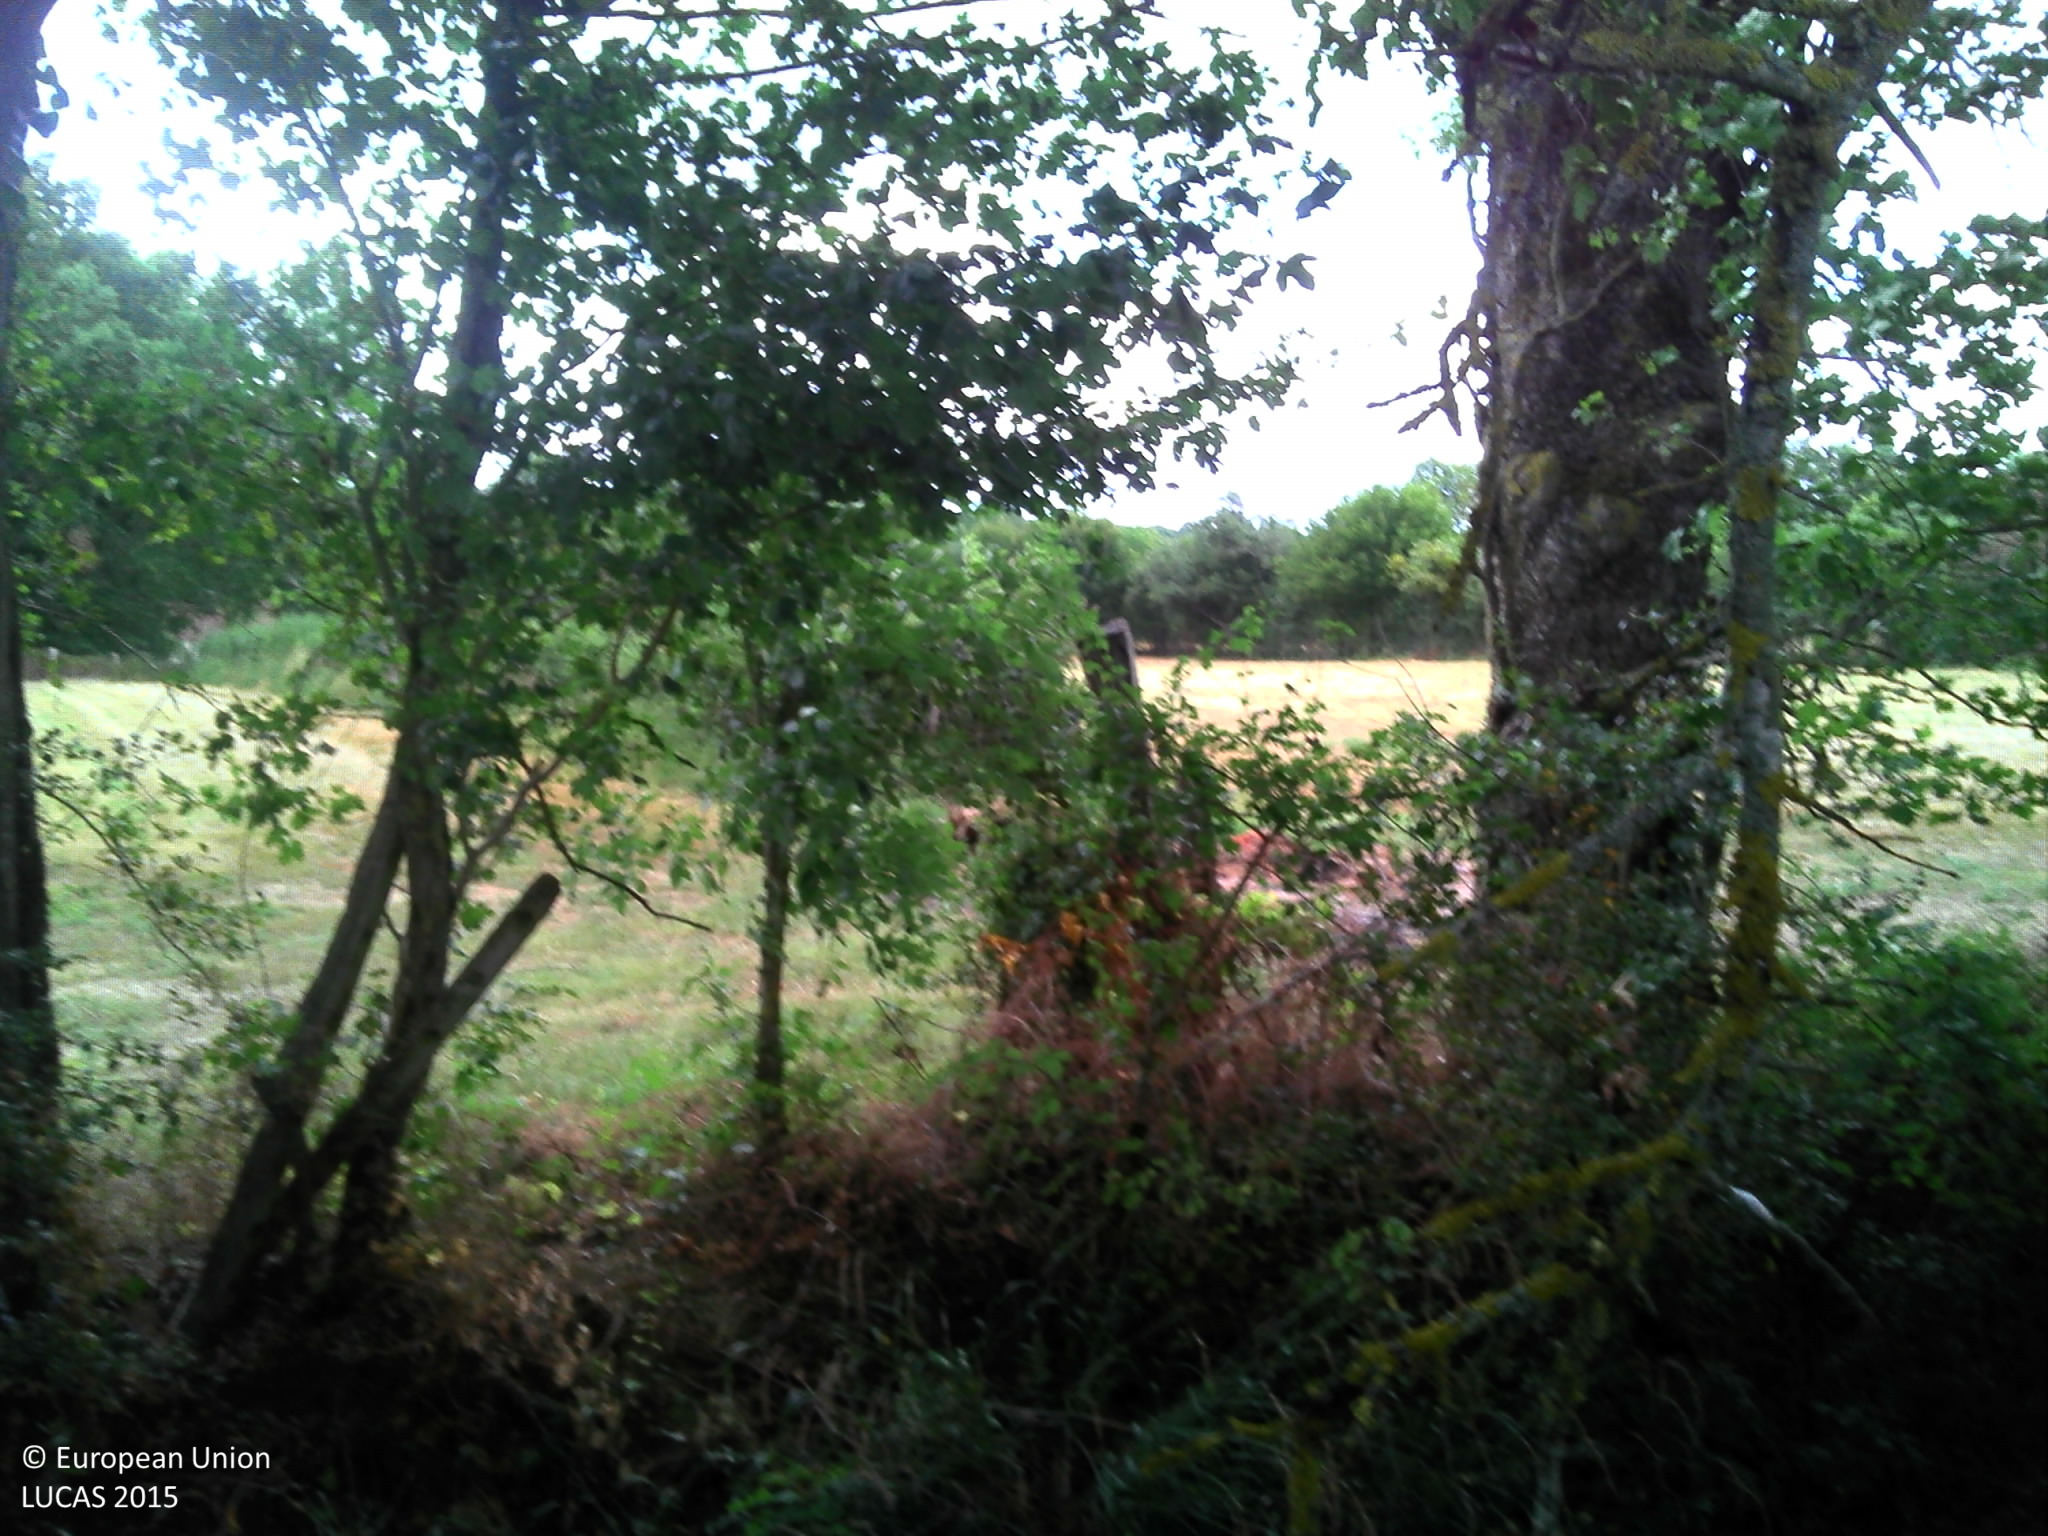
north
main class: Woodland
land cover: Broadleaved woodland
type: mesophytic deciduous forest
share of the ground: > 75 %
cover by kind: broadleaved forest trees 100 %
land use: Agriculture (excluding fallow land and kitchen gardens)
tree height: > 5 m
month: July
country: FR
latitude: 46.6963
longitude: 2.1594
